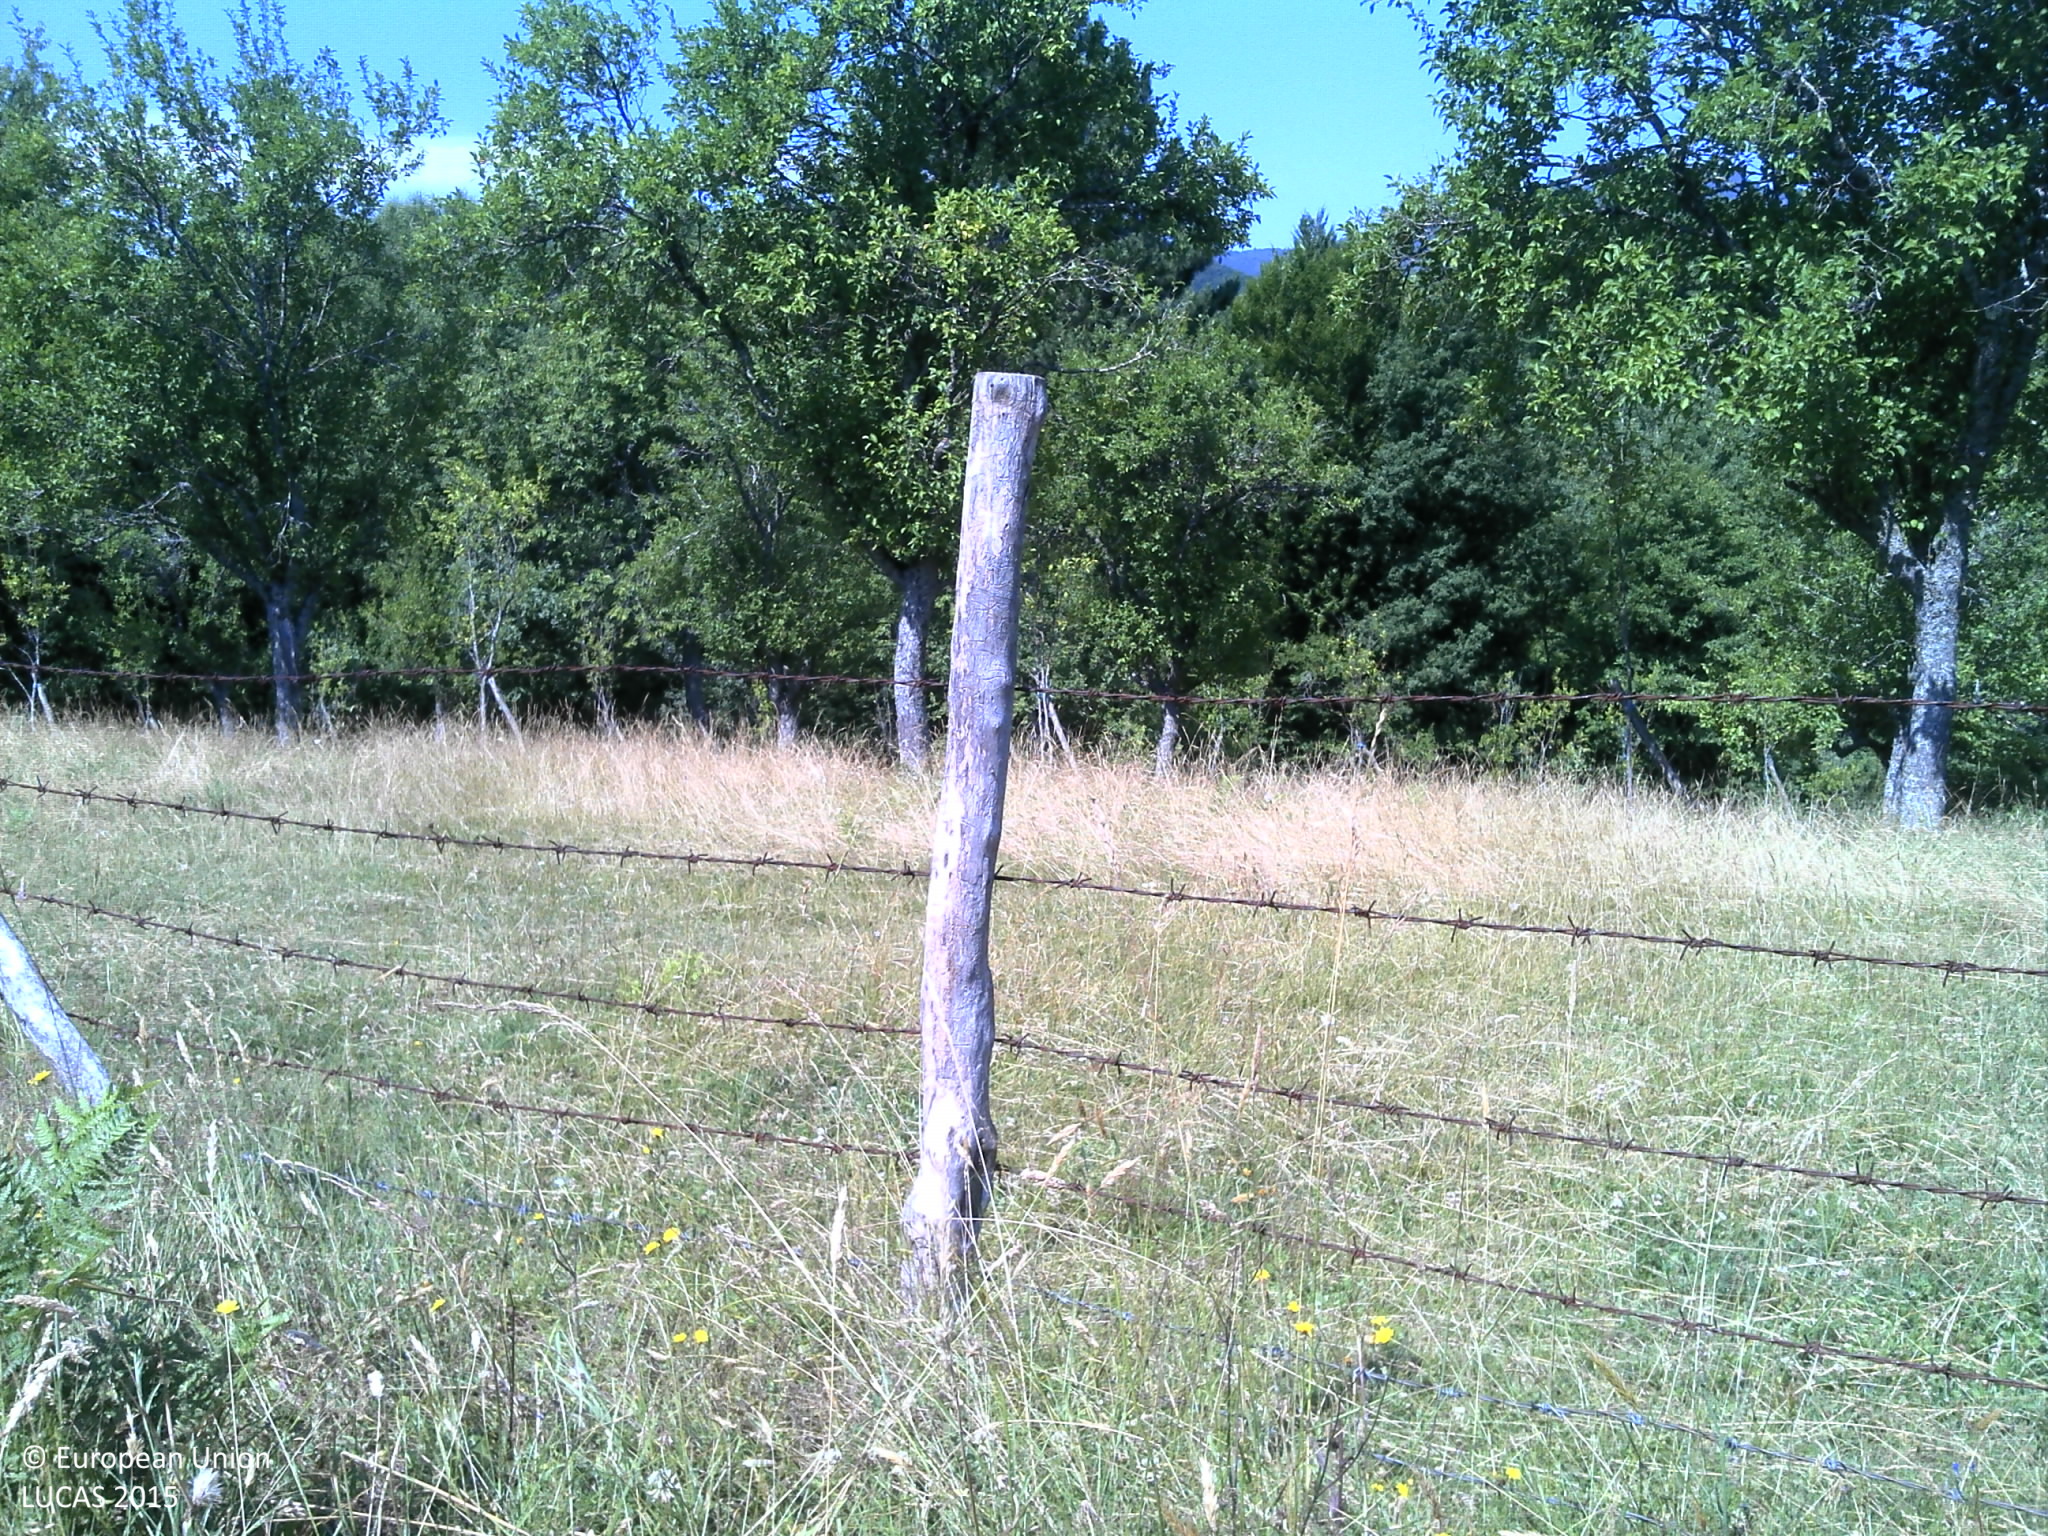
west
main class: Cropland
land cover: Other fruit trees and berries
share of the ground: 25 - 50 %
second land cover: Grassland without tree/shrub cover
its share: > 75 %
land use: Agriculture (excluding fallow land and kitchen gardens)
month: July
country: HR
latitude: 44.6370
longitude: 15.1748
